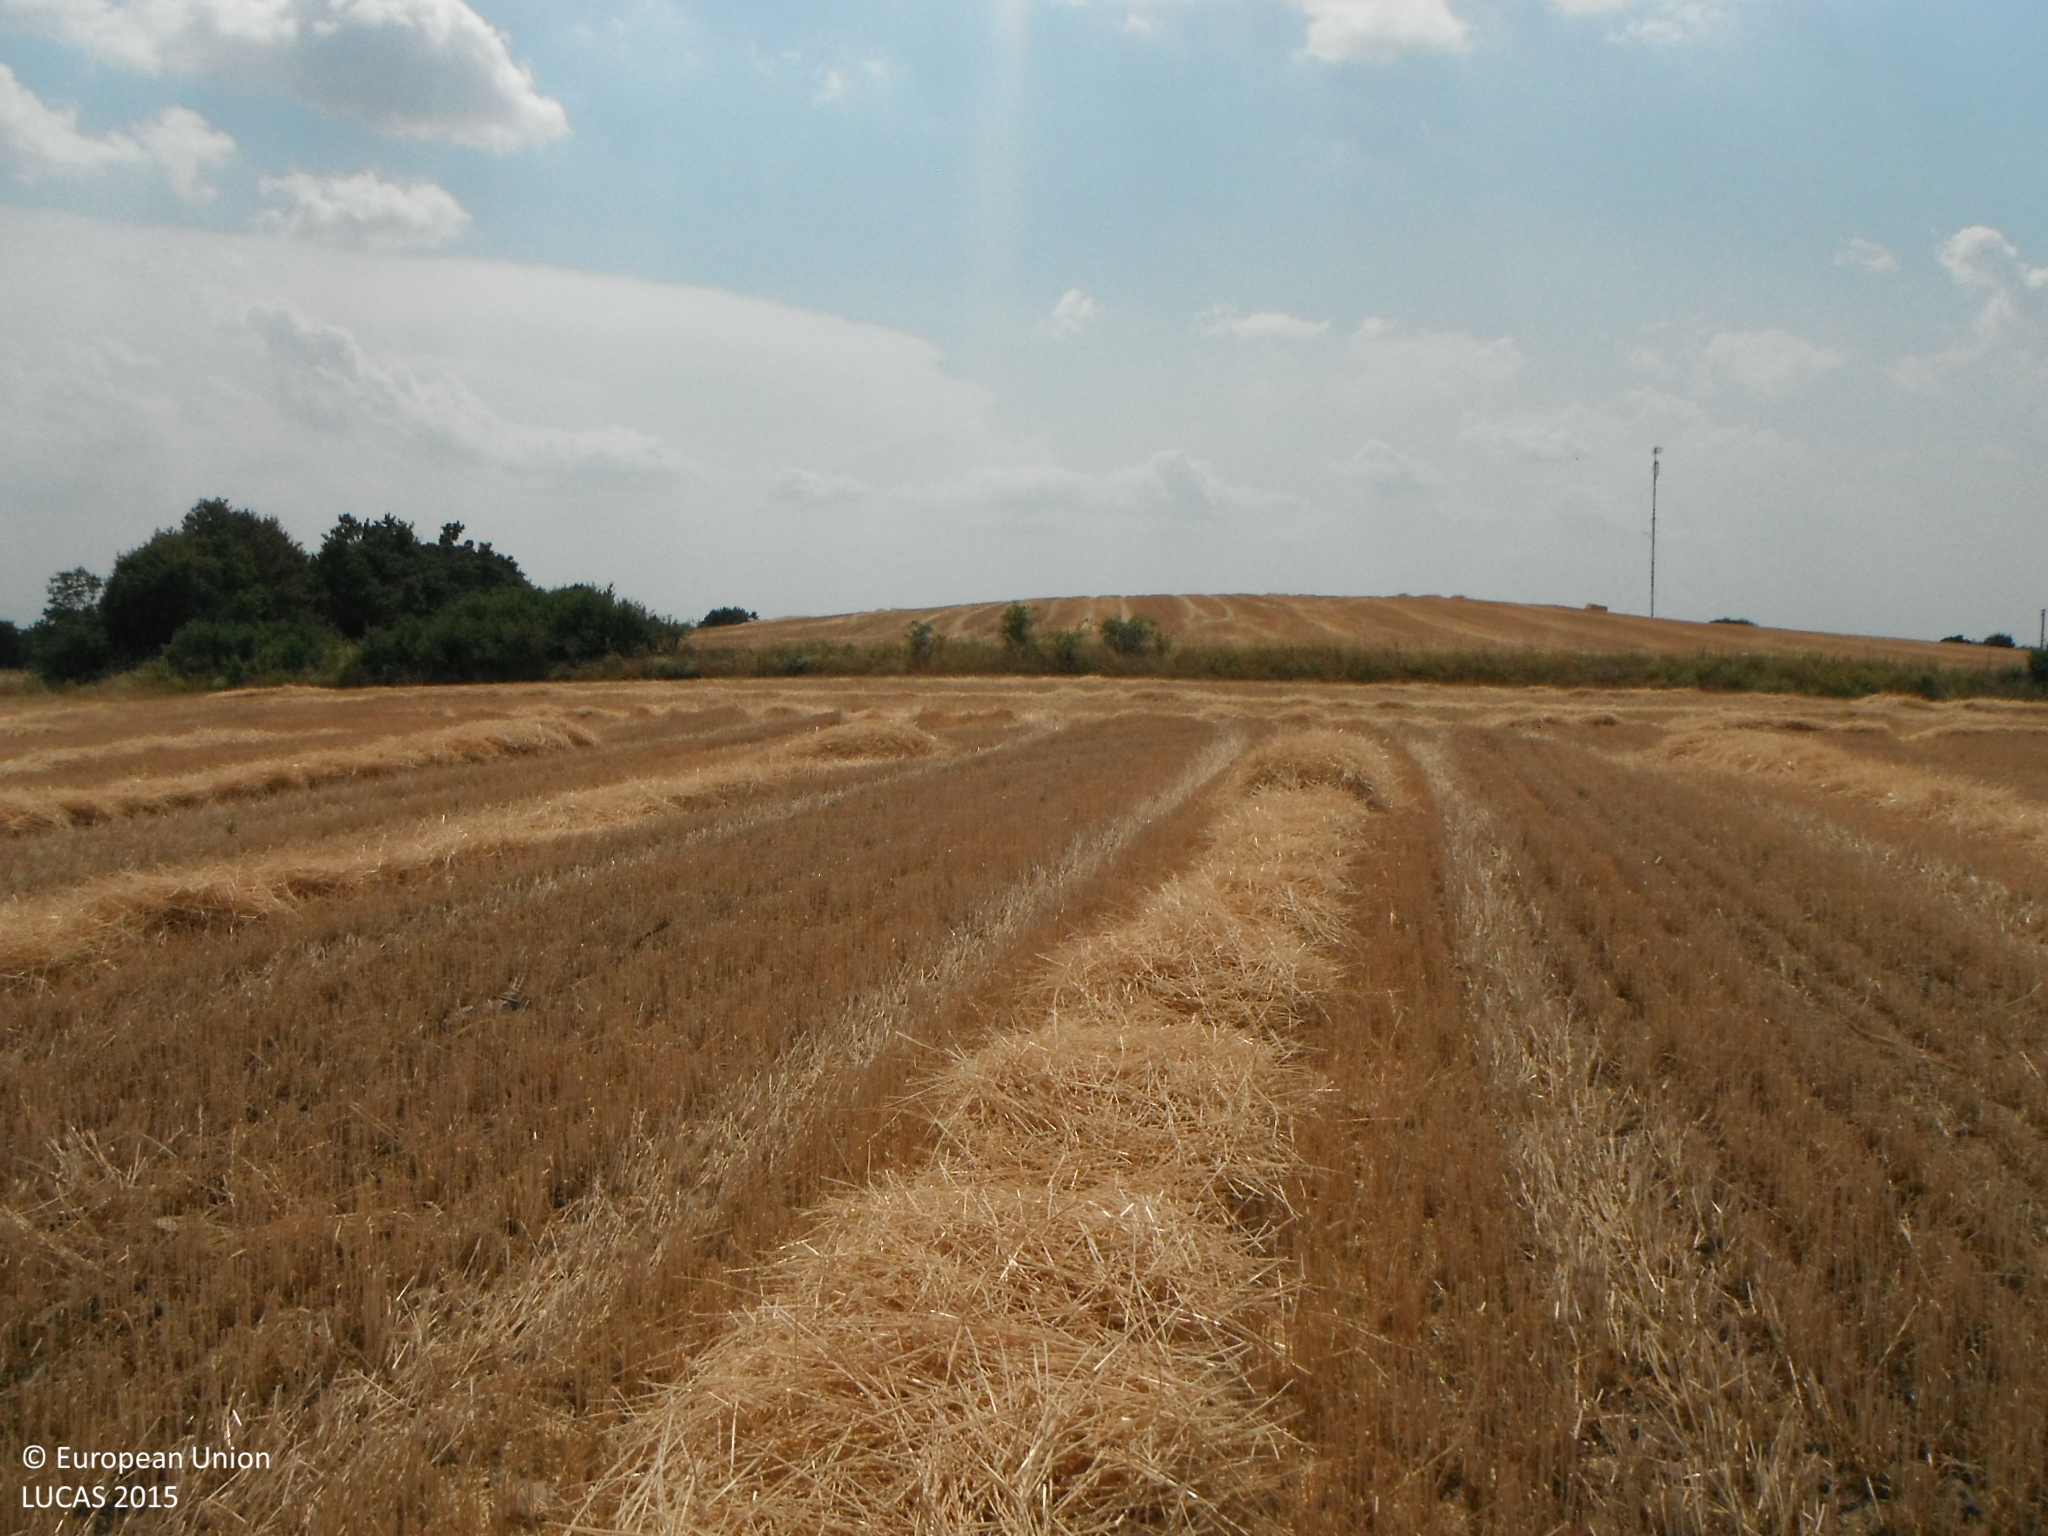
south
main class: Cropland
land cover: Common wheat
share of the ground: > 75 %
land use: Agriculture (excluding fallow land and kitchen gardens)
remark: Harvested field
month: July
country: SK
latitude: 48.3510
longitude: 19.1299
